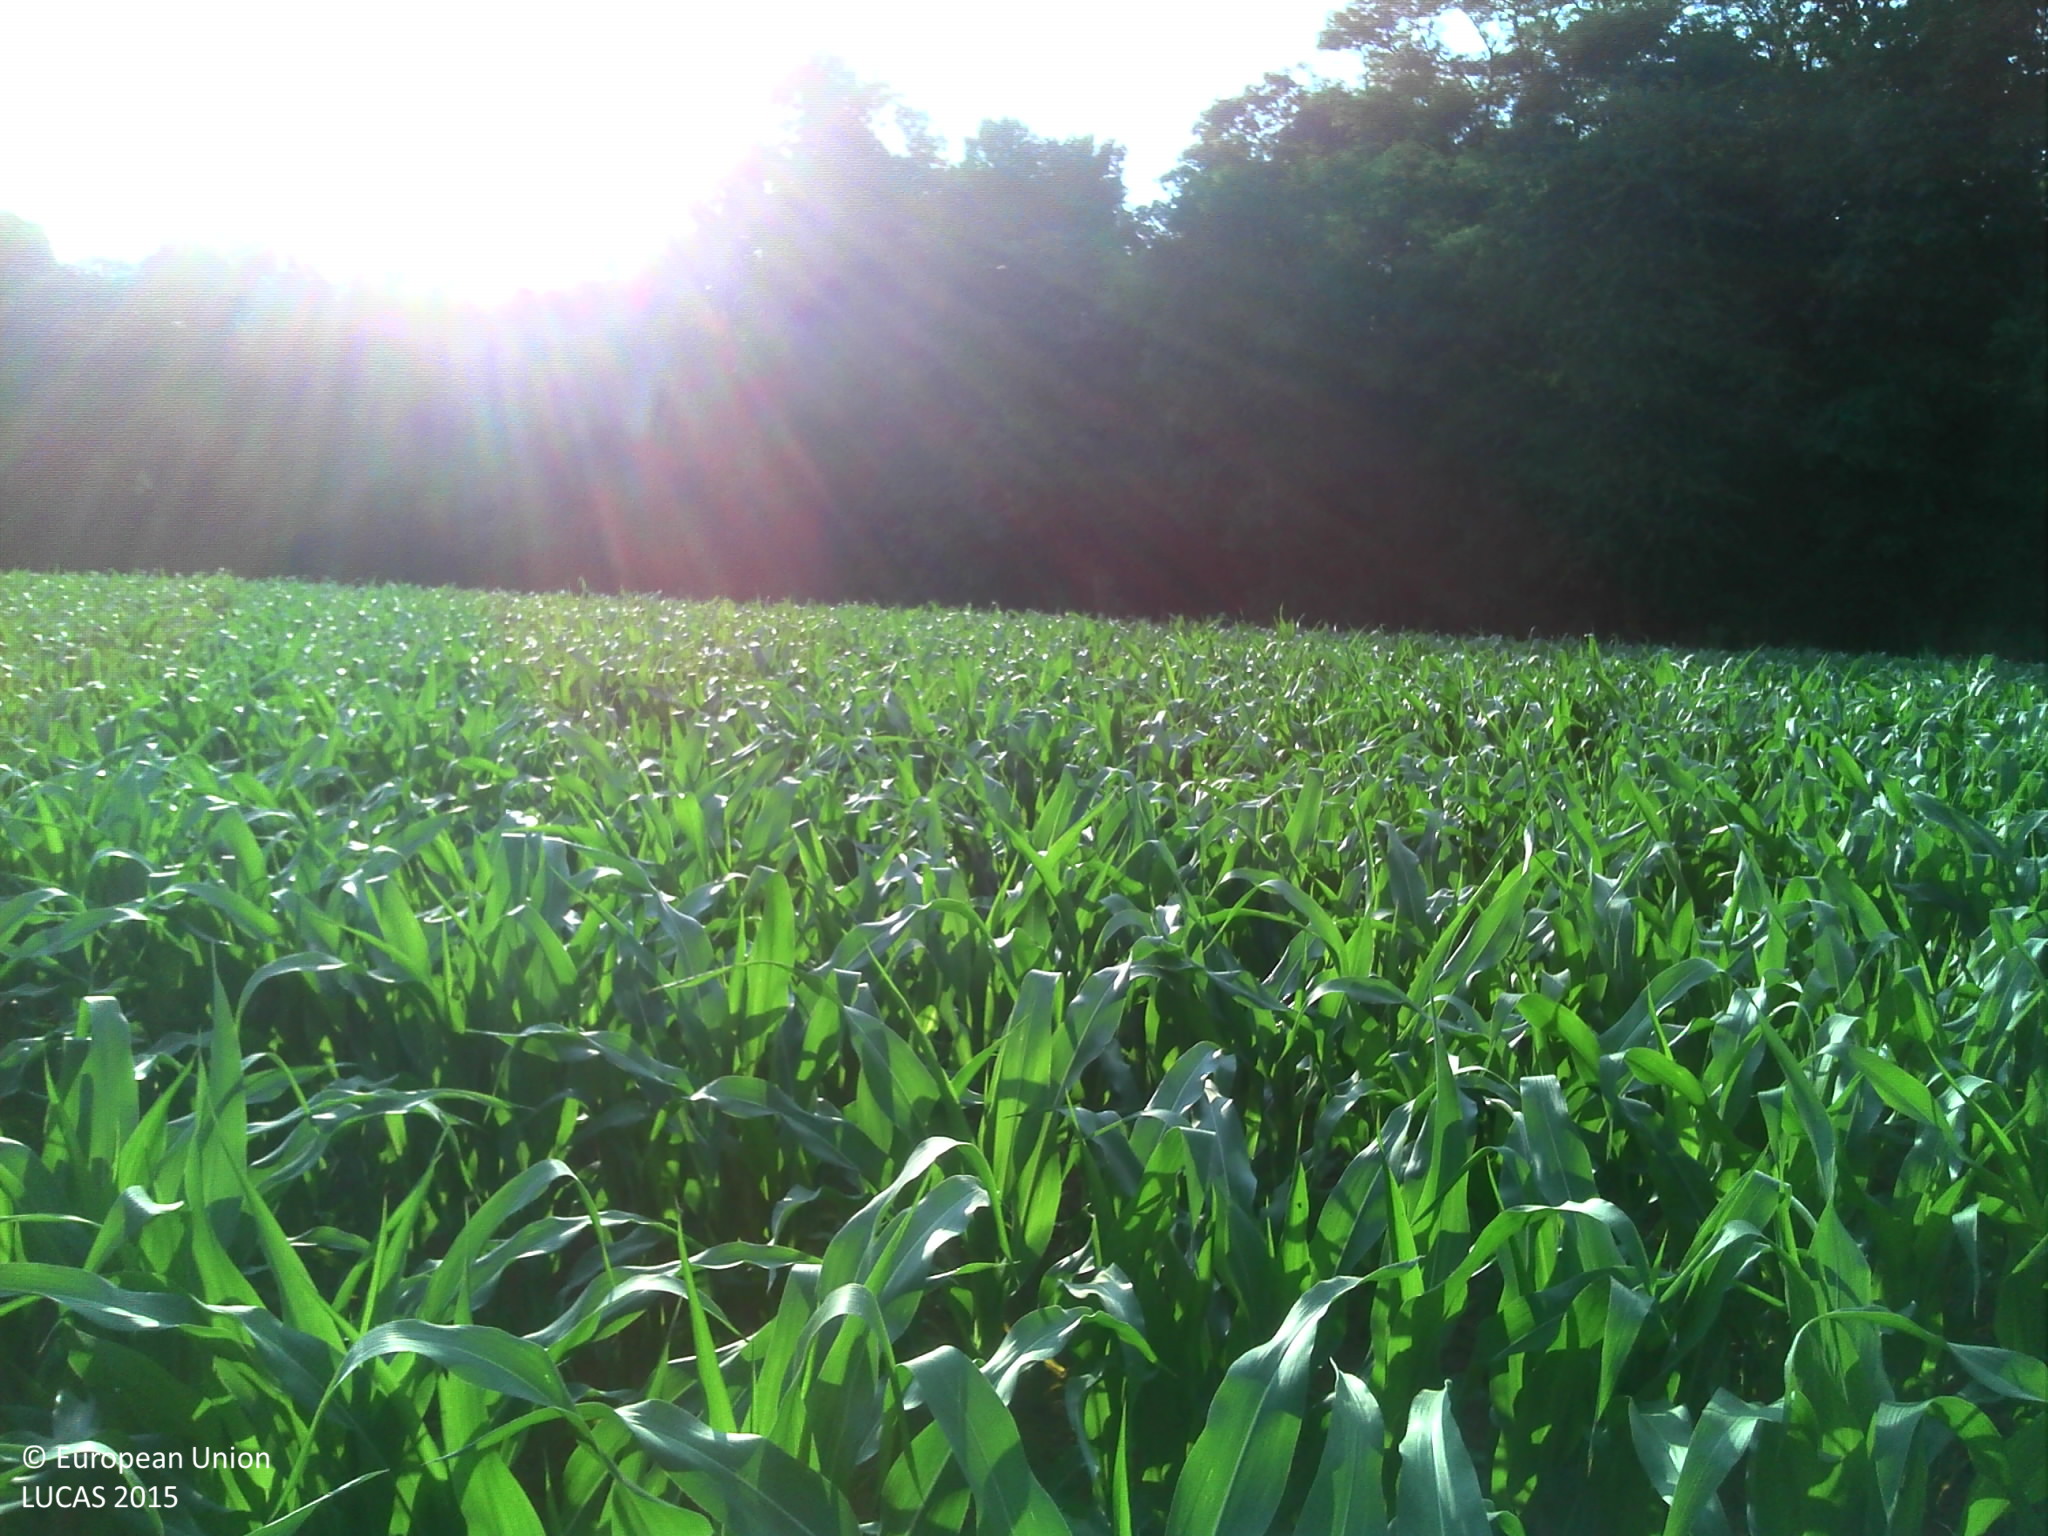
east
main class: Cropland
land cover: Maize
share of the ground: 25 - 50 %
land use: Agriculture (excluding fallow land and kitchen gardens)
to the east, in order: Maize; Grass margins; Broadleaved woodland; Grass margins; Tracks; Ditches and canals; Broadleaved woodland
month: July
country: FR
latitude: 48.8013
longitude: 5.1379
